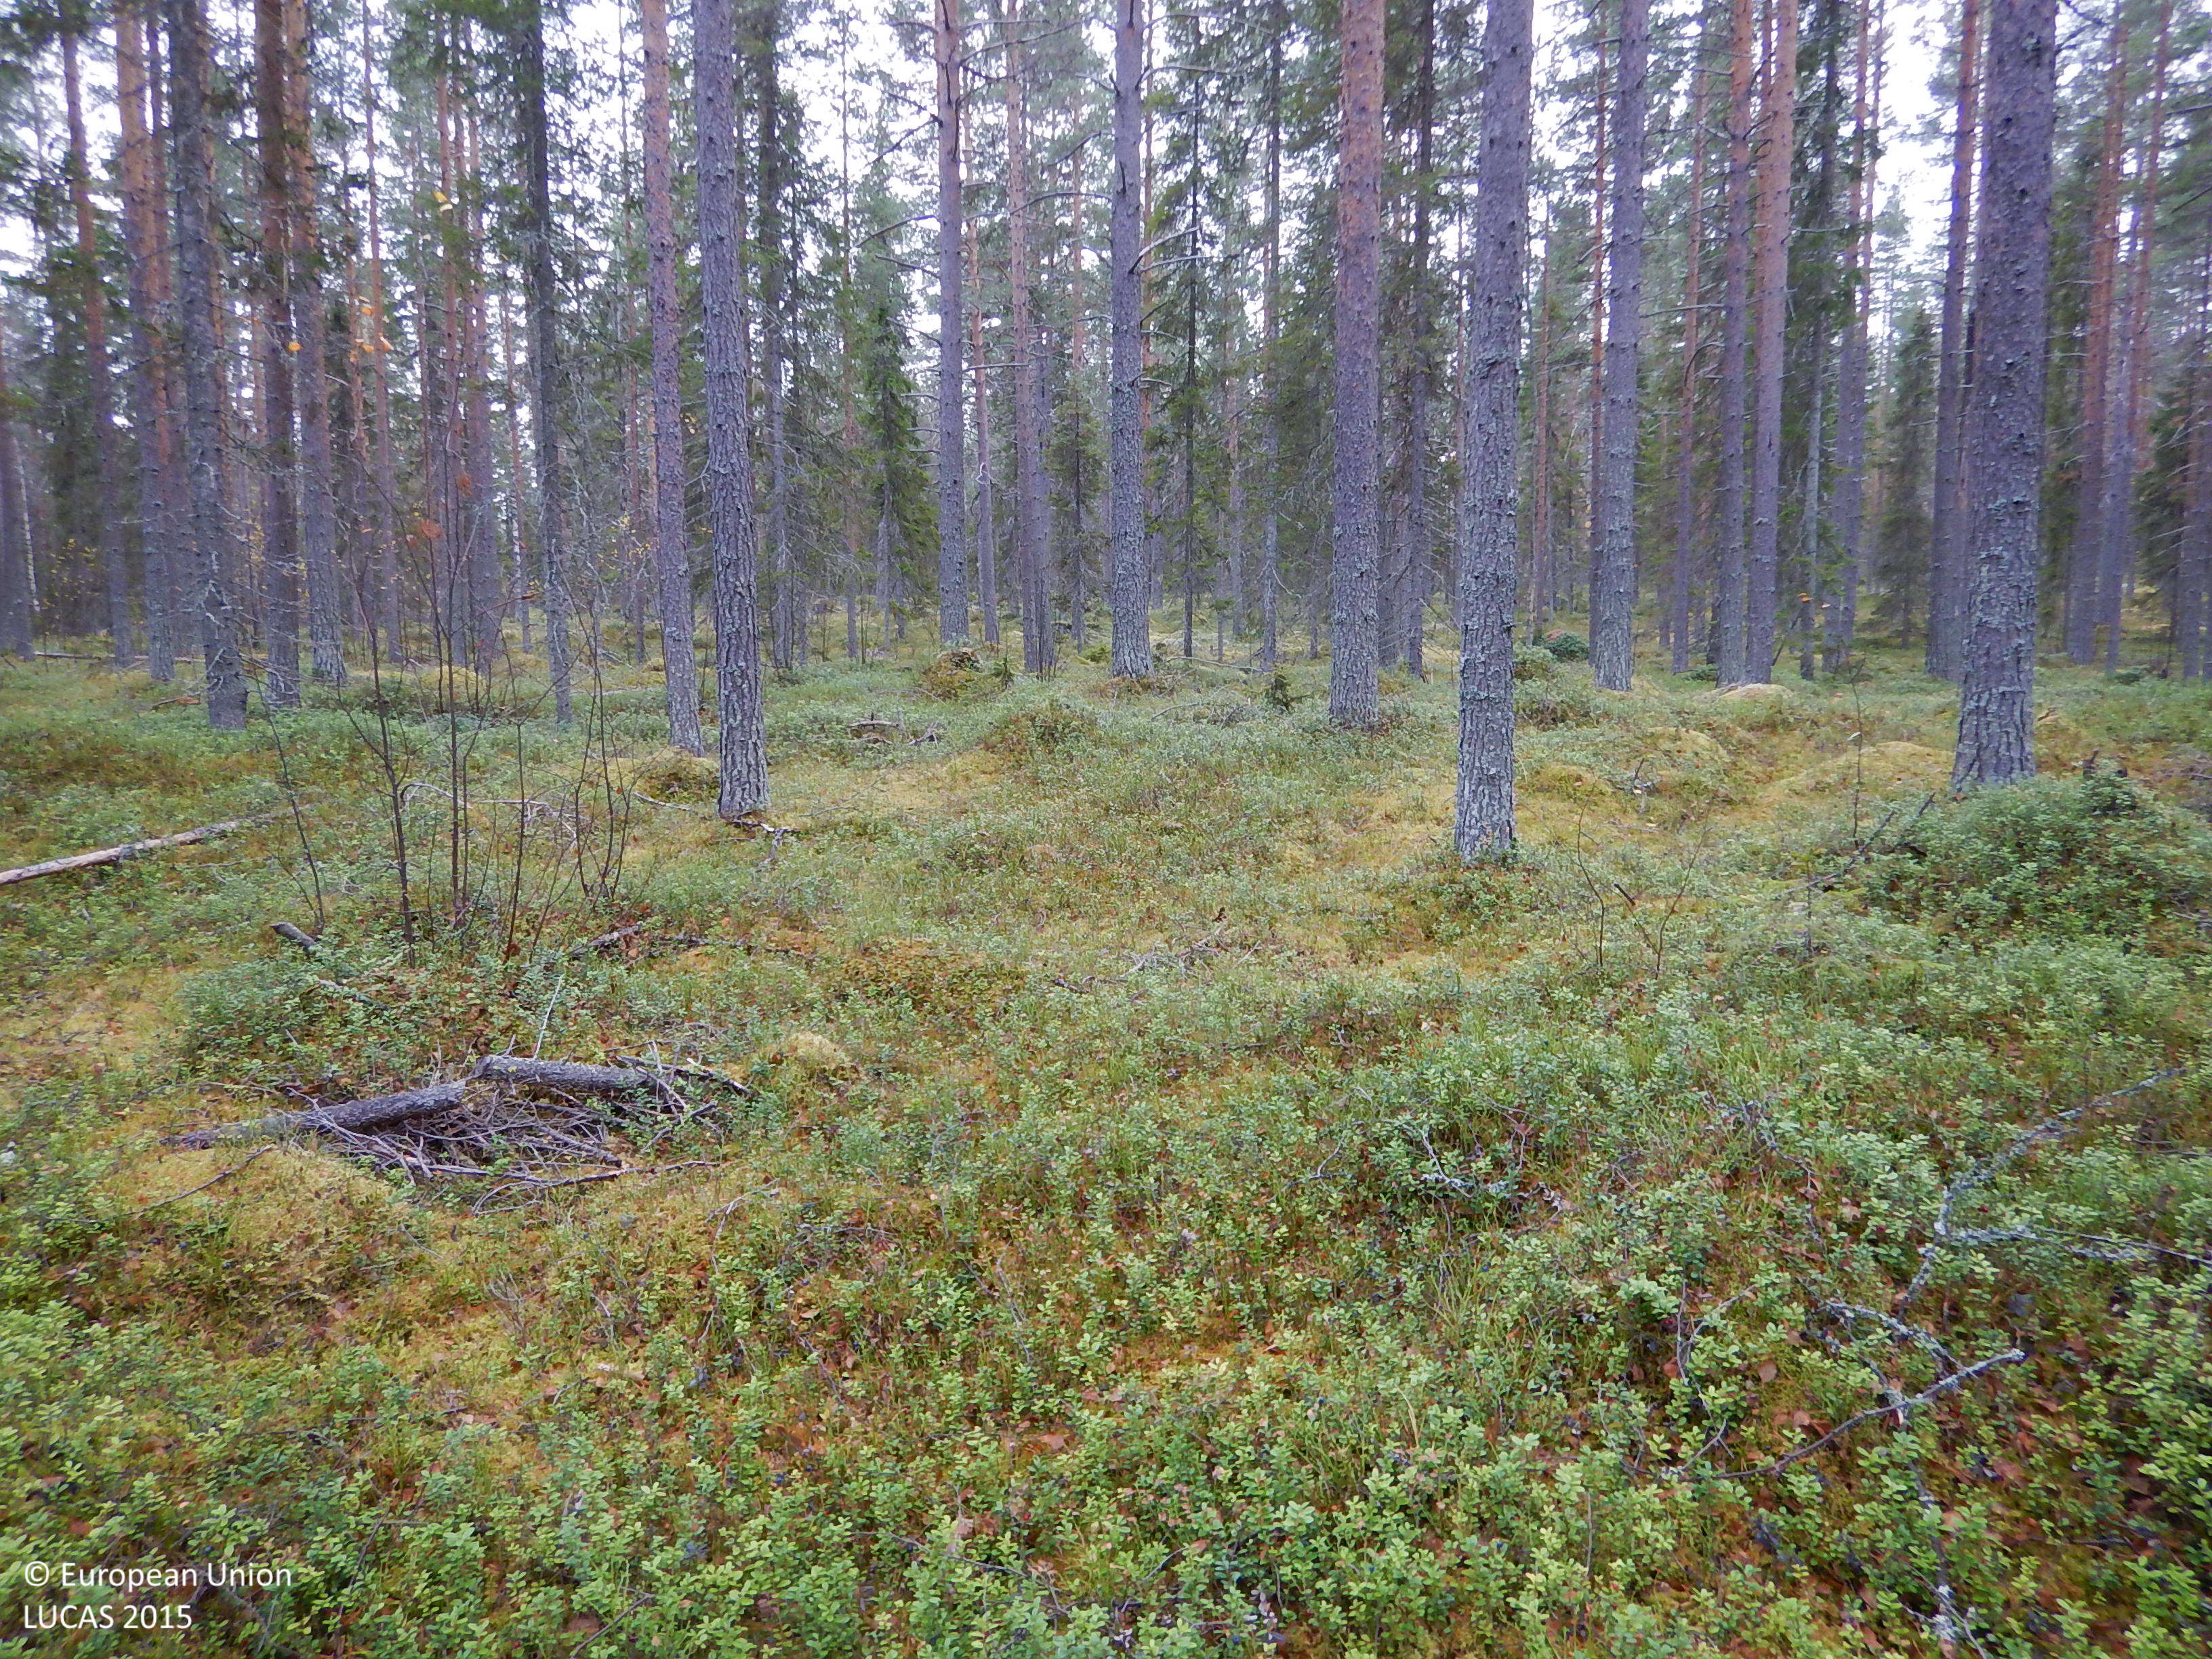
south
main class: Woodland
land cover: Pine dominated coniferous woodland
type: boreal forest
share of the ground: 50 - 75 %
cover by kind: coniferous forest trees 60 %, shrubs 20 %, lichens and mosses 10 %, broadleaved forest trees 5 %, herbaceous plants 5 %
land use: Forestry
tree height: > 5 m
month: October
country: SE
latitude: 65.1217
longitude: 21.1171
